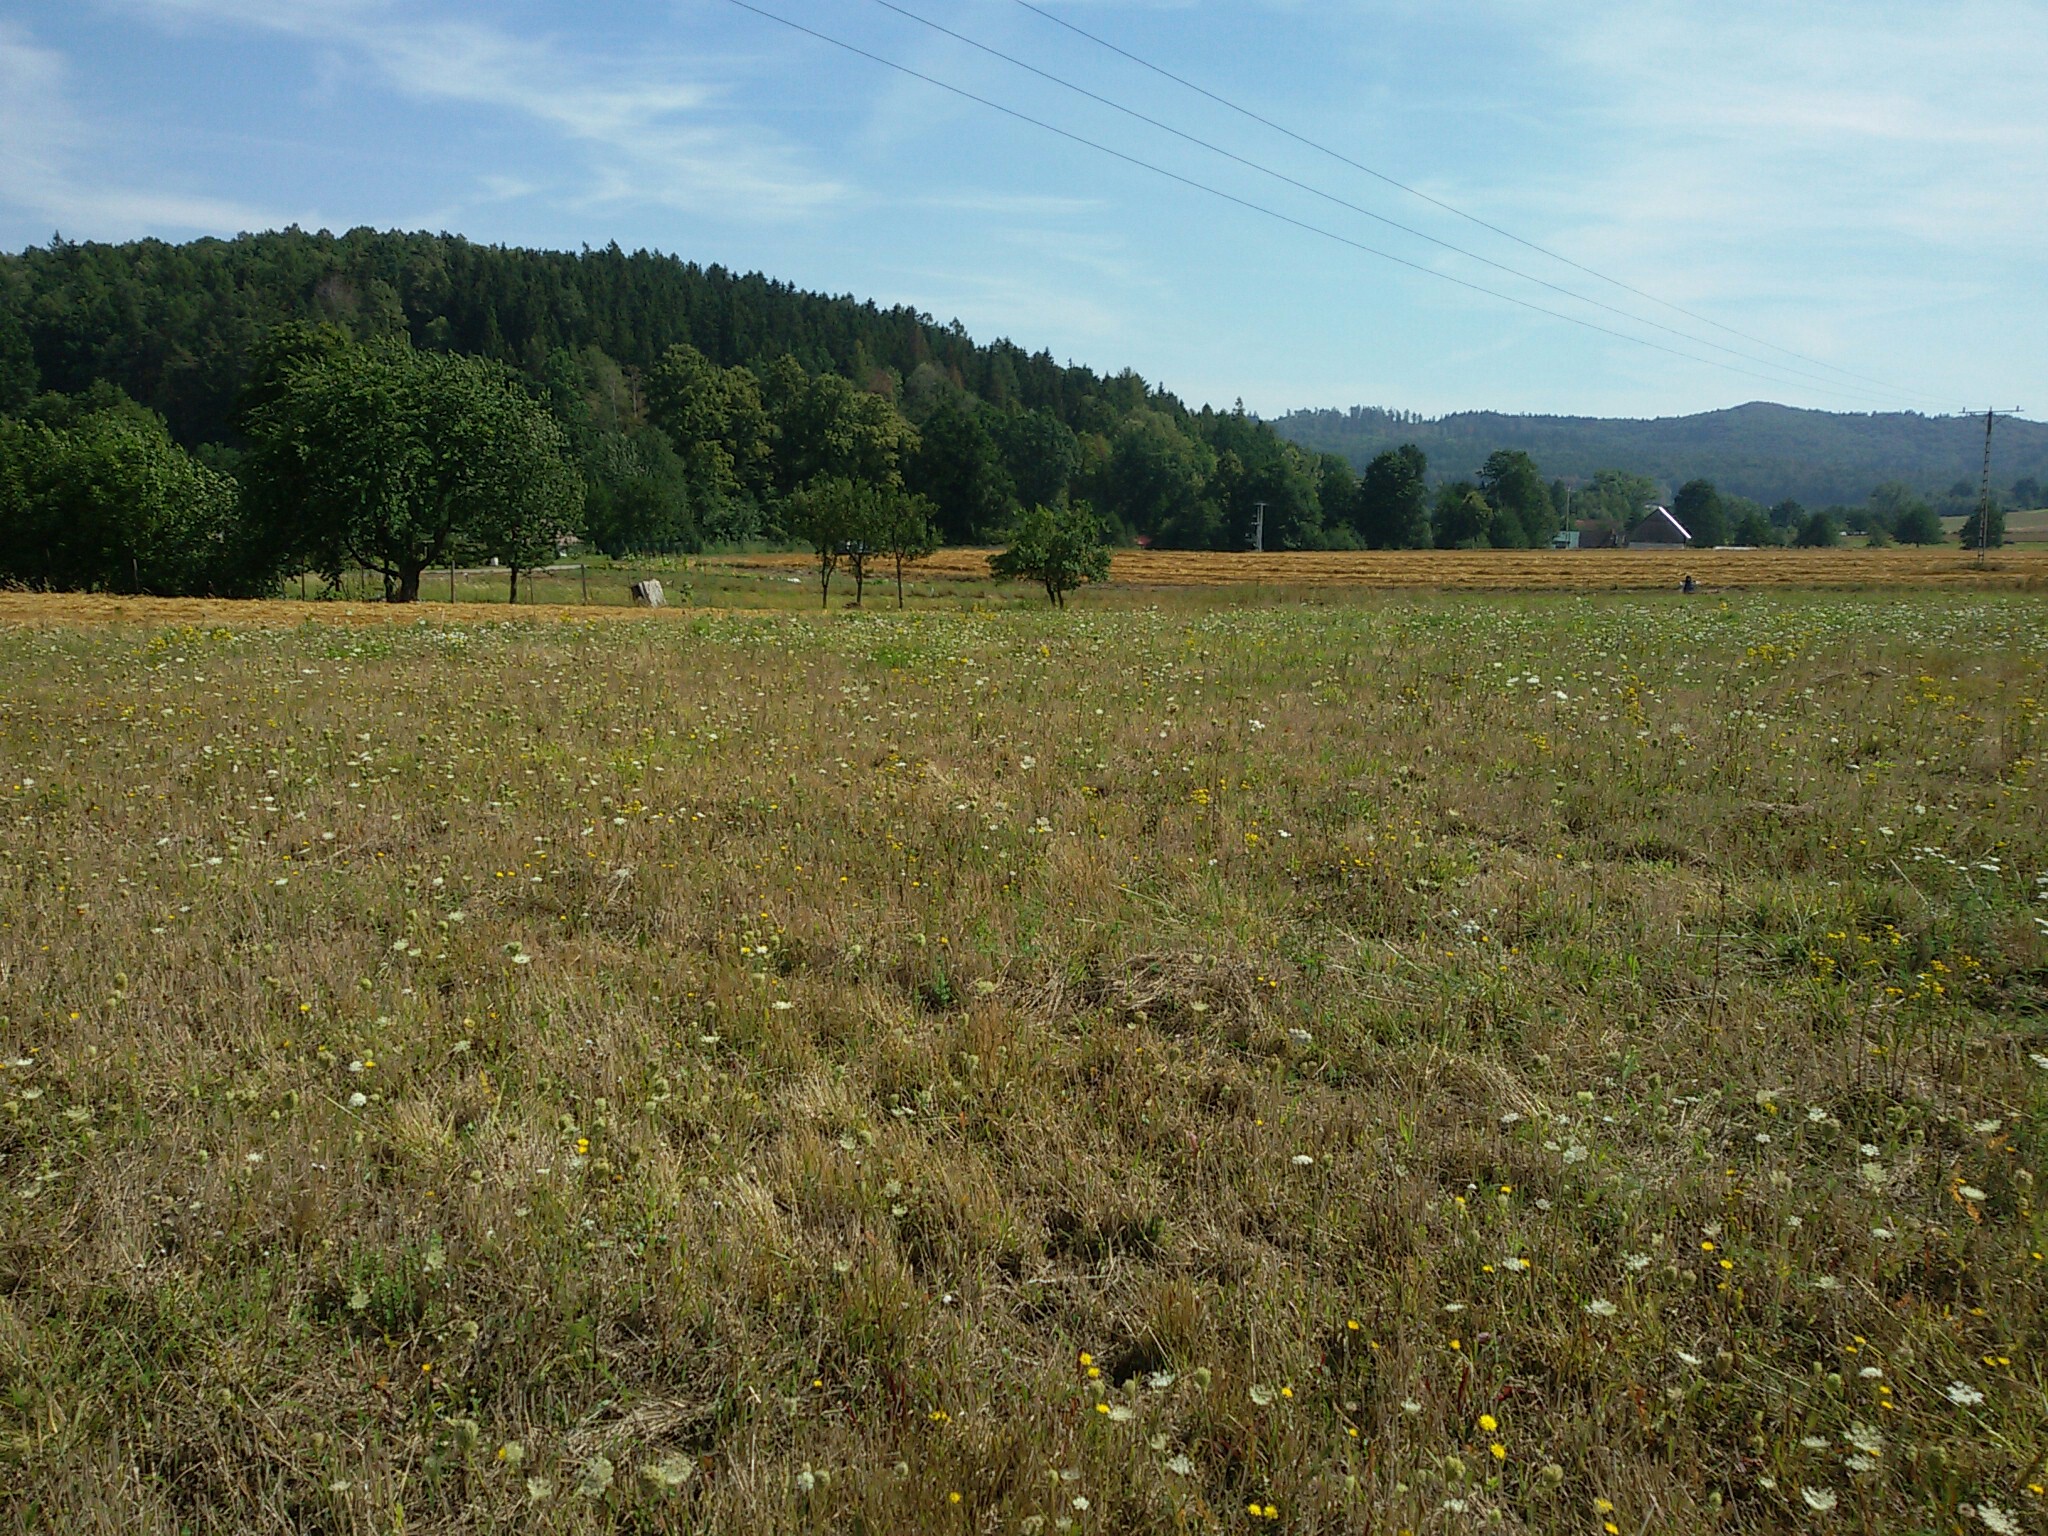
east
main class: Grassland
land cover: Grassland without tree/shrub cover
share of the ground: > 75 %
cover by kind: herbaceous plants 100 %
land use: Agriculture (excluding fallow land and kitchen gardens)
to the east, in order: Grassland without tree/shrub cover; Electric lines; Oats; Fences; Grassland with sparse tree/shrub cover; Fences; Grassland without tree/shrub cover; Other fresh vegetables; Oats; Tracks; Grass margins; Fences; Spontaneously vegetated surfaces; Fences; Spontaneously vegetated surfaces
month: August
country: PL
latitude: 50.3847
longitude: 16.6889
